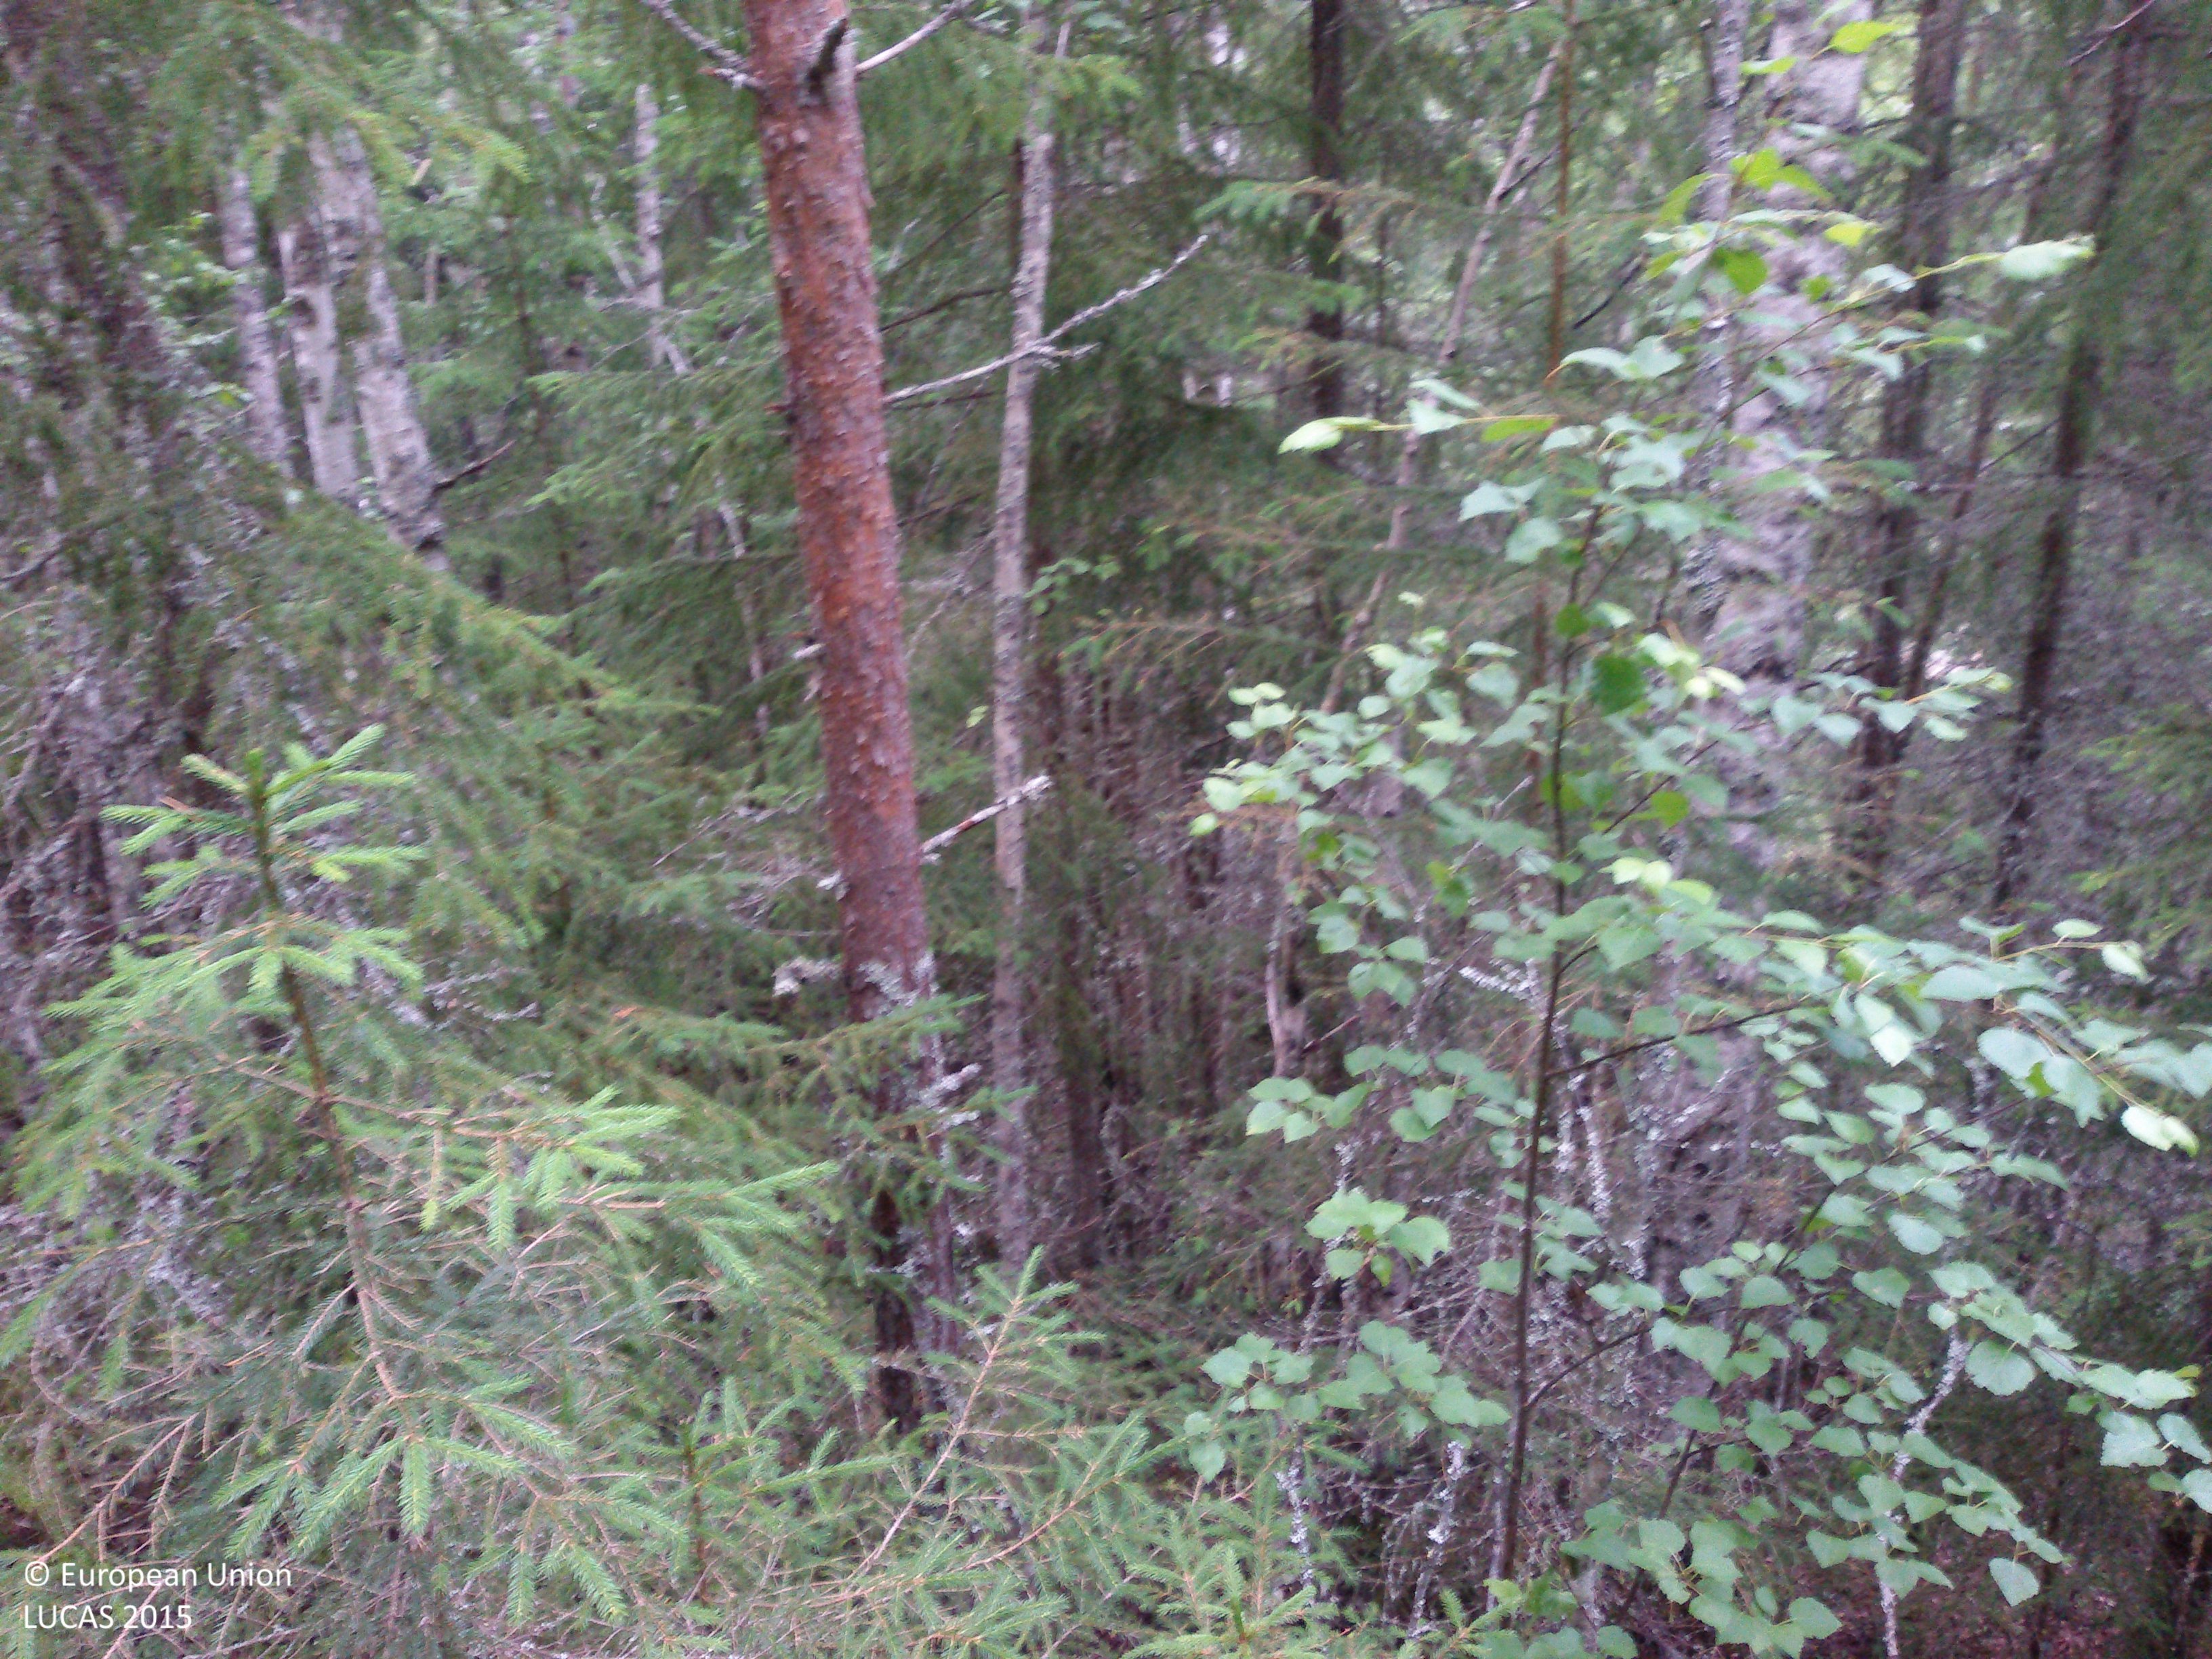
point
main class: Woodland
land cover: Spruce dominated mixed woodland
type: boreal forest
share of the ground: > 75 %
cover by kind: coniferous forest trees 70 %, broadleaved forest trees 30 %
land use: Forestry
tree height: > 5 m
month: July
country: SE
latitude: 60.4379
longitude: 14.9123
